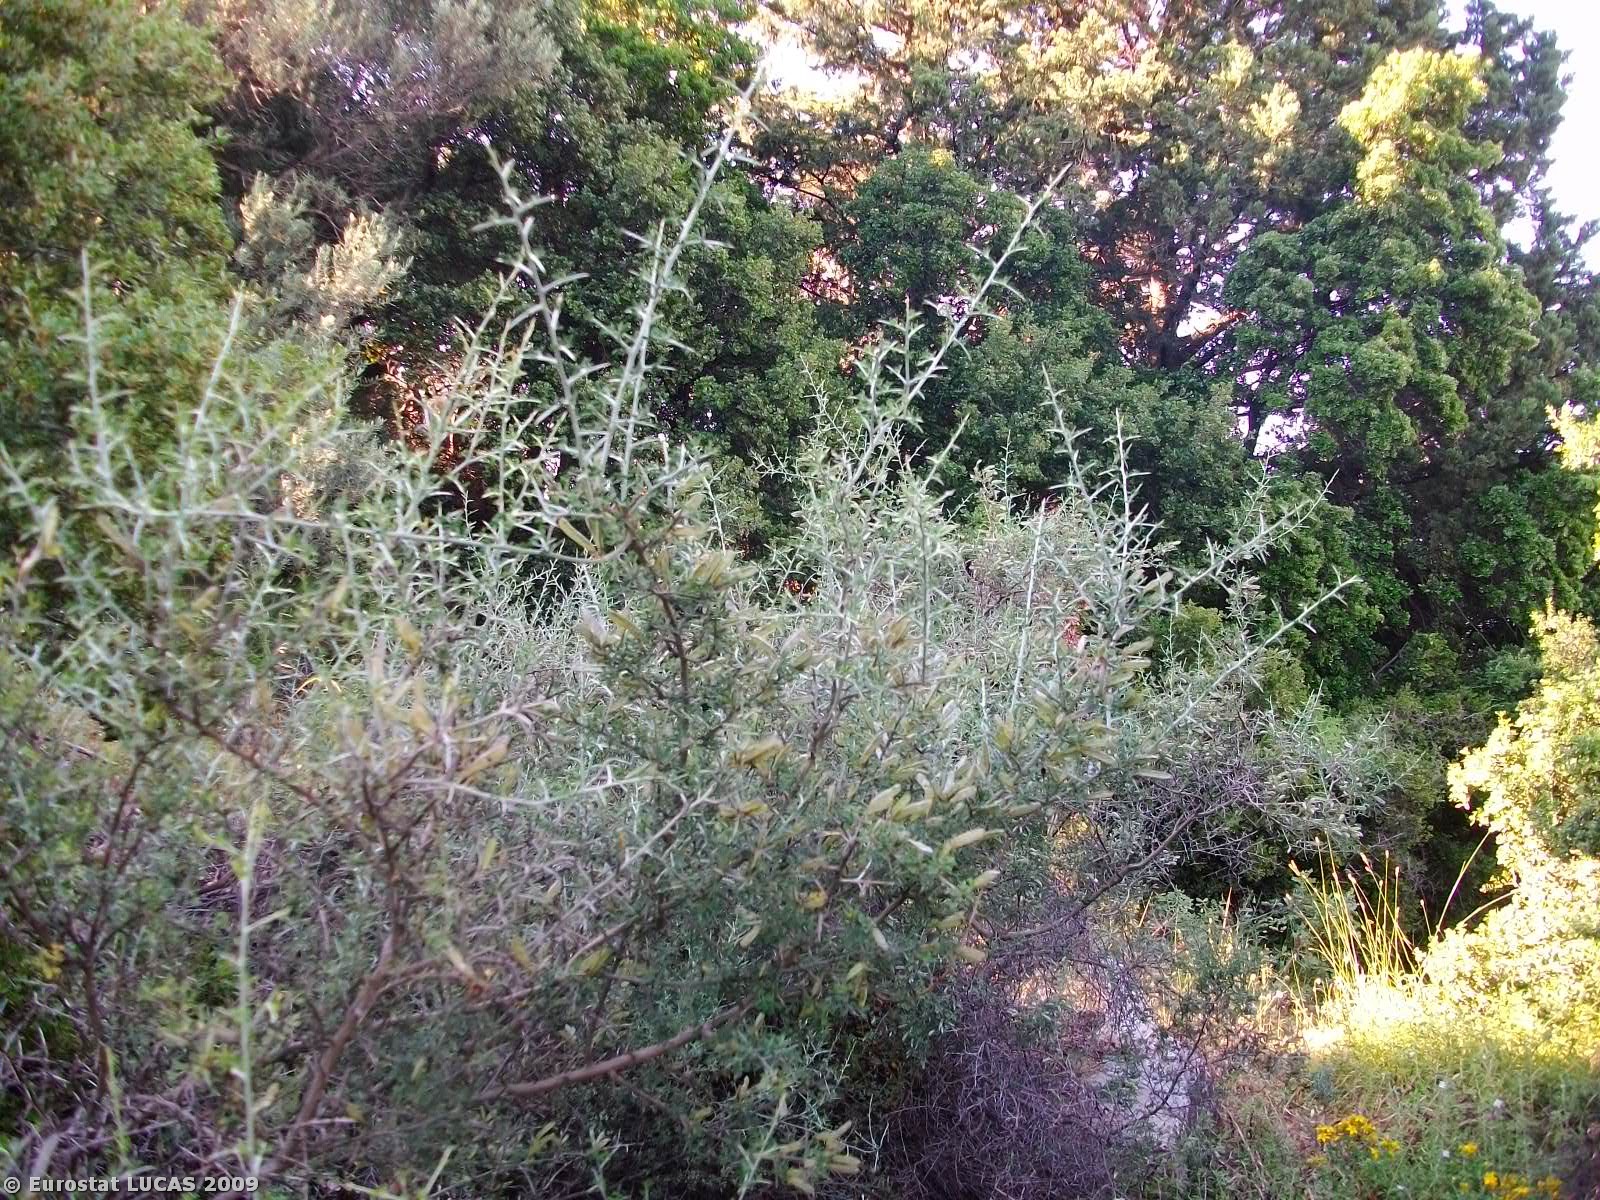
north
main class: Shrubland
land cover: Shrubland with sparse tree cover
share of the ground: > 75 %
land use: Unused
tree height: > 5 m
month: May
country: GR
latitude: 37.0840
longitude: 22.3638
